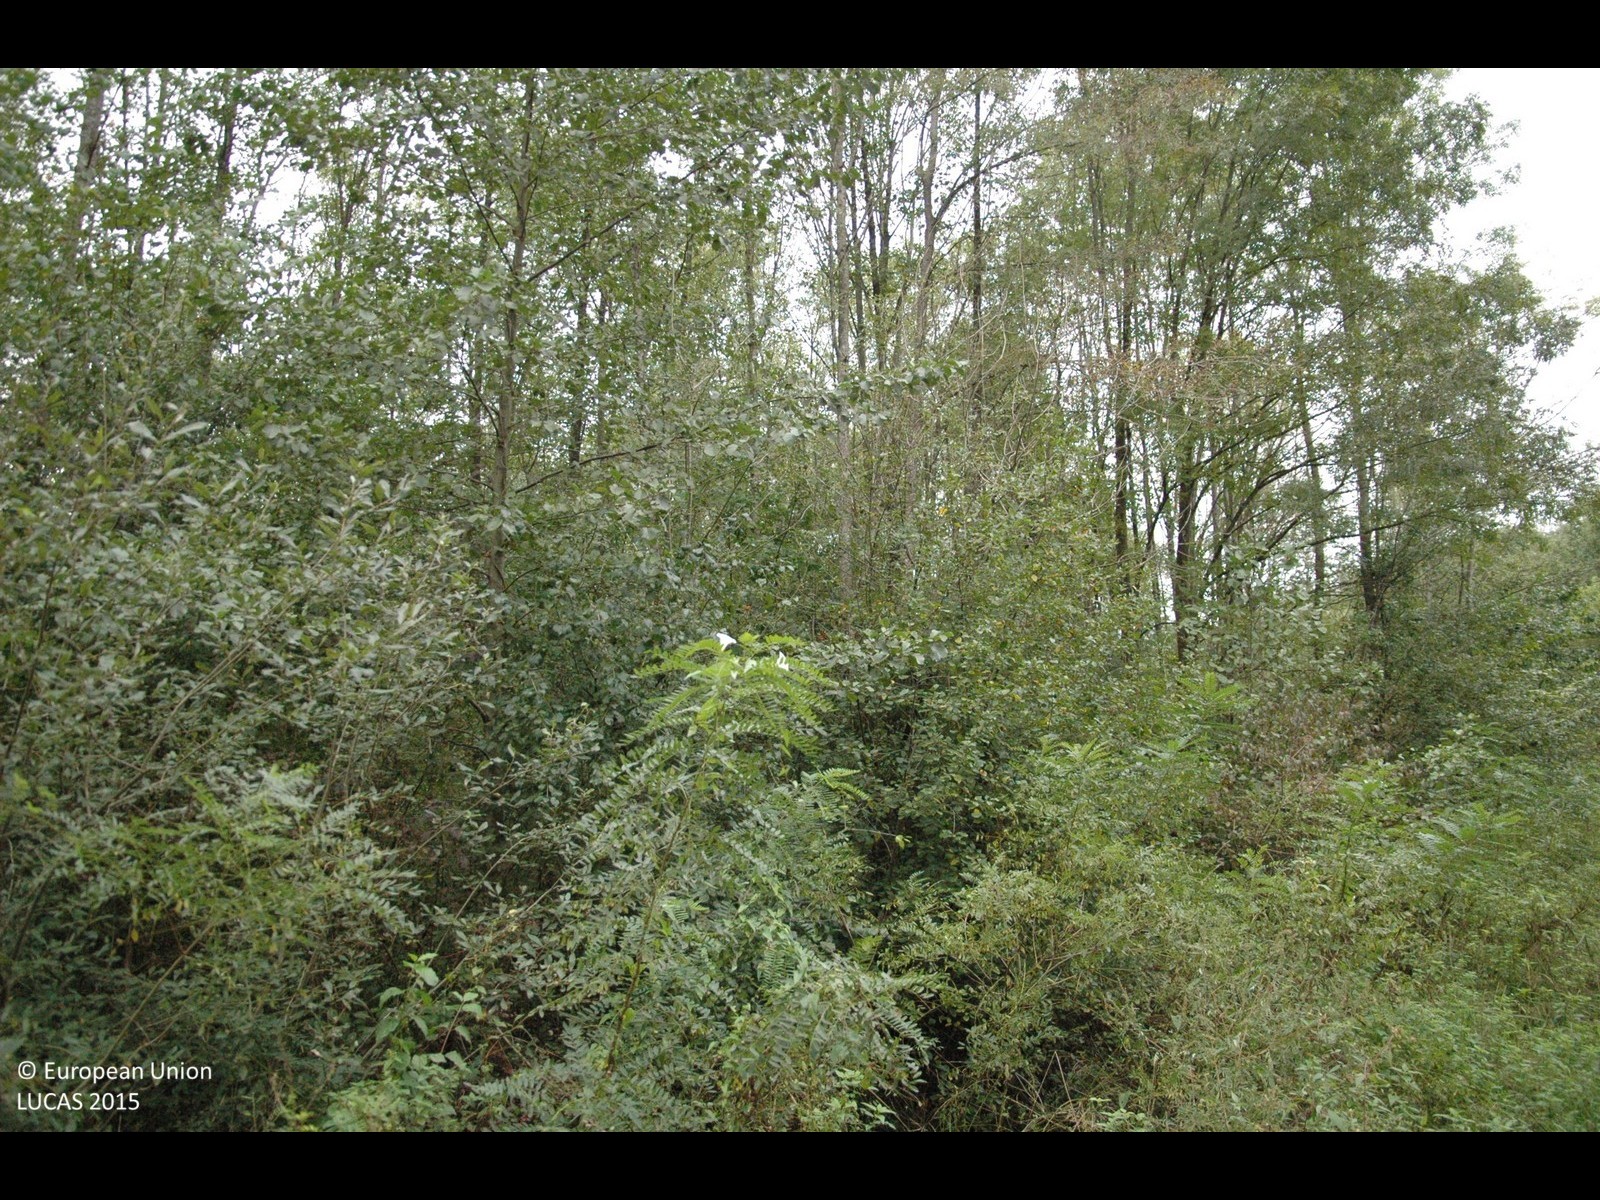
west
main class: Woodland
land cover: Broadleaved woodland
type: floodplain forest
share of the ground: > 75 %
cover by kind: broadleaved forest trees 100 %
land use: Forestry
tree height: > 5 m
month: October
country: HR
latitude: 45.5714
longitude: 16.2638
